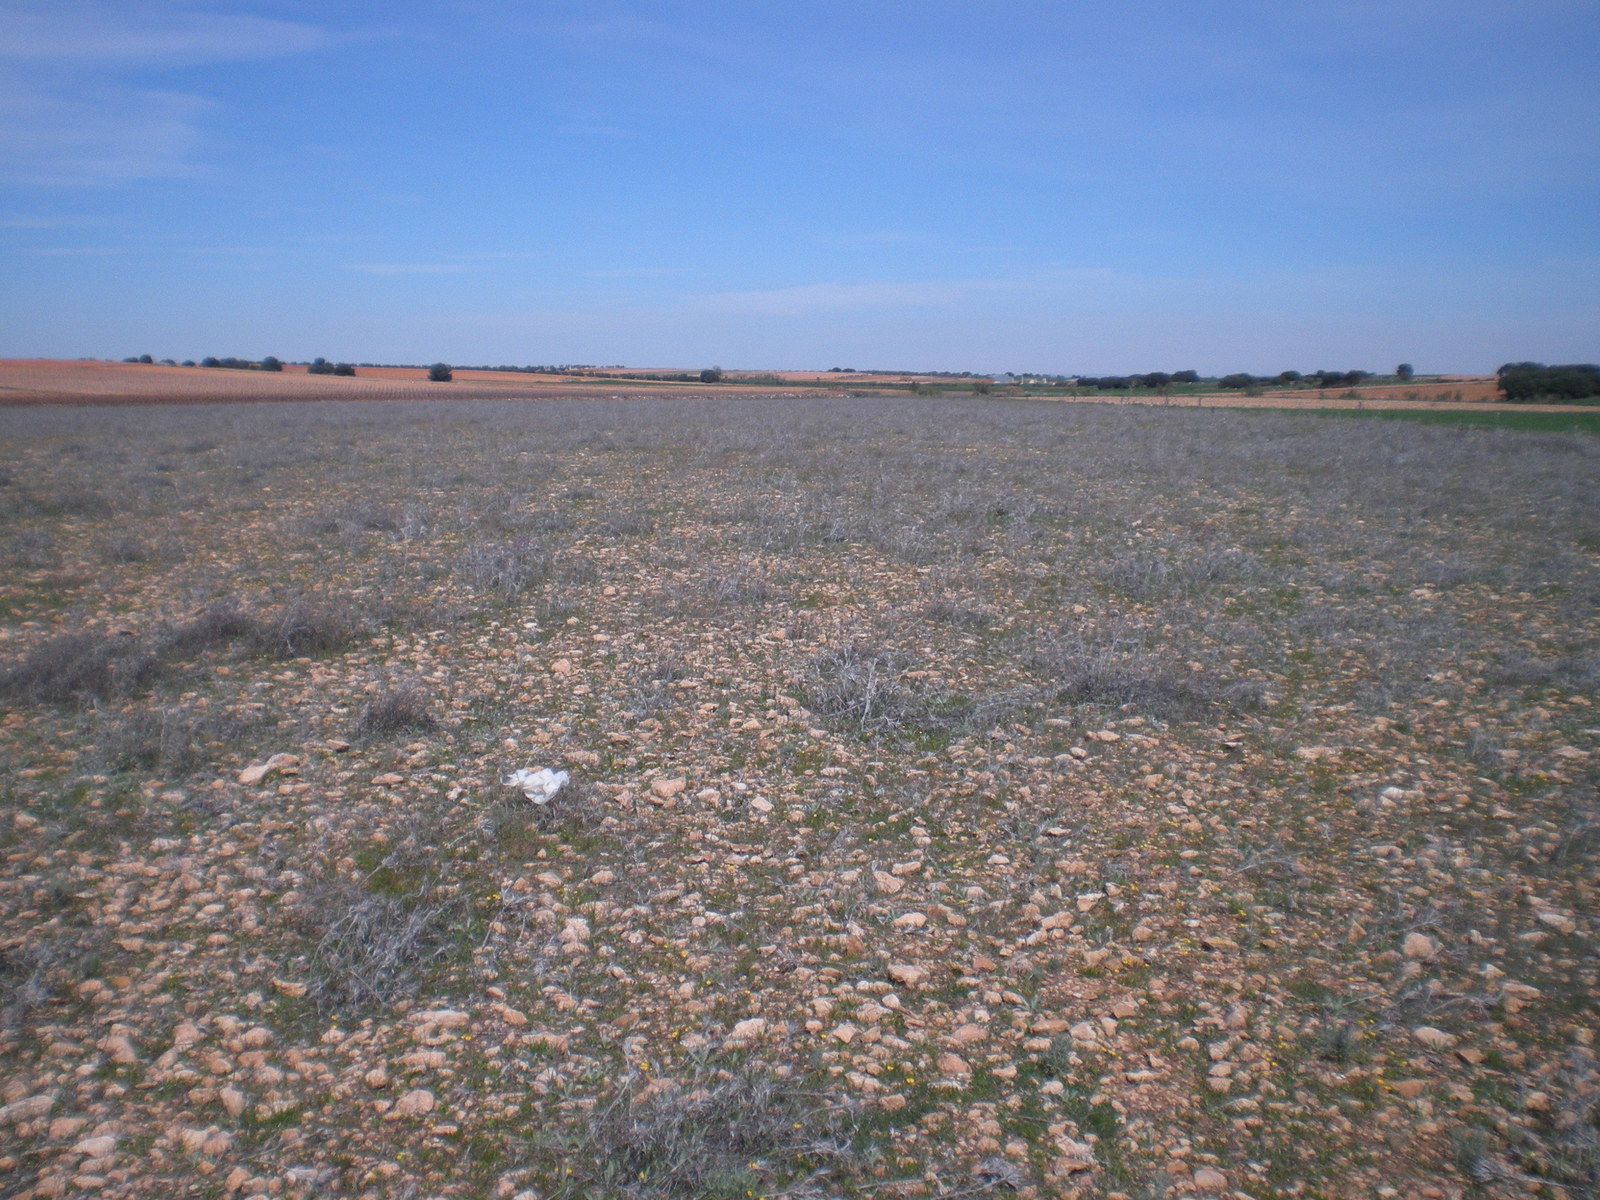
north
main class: Grassland
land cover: Spontaneously vegetated surfaces
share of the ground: > 75 %
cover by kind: herbaceous plants 90 %, unconsolidated bare surface 10 %
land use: Agriculture (excluding fallow land and kitchen gardens)
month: March
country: ES
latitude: 39.0390
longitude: -3.2182
